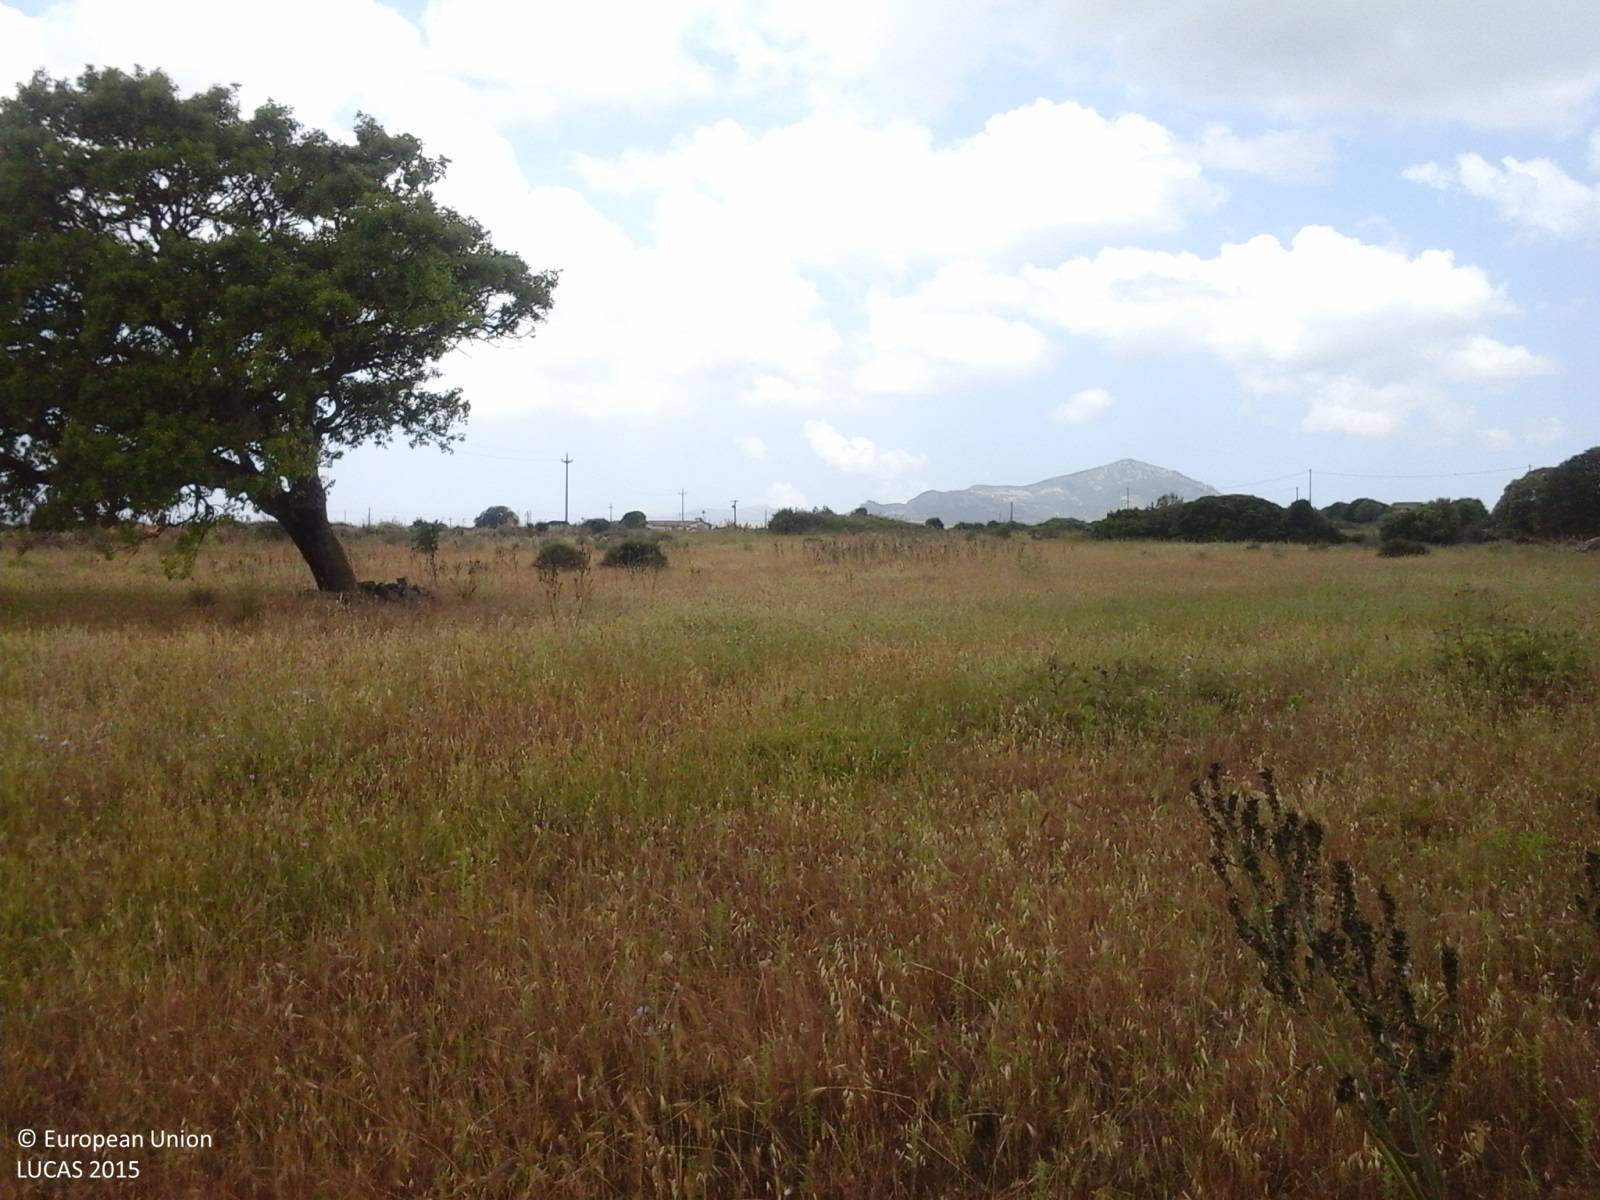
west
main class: Grassland
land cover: Grassland without tree/shrub cover
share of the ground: > 75 %
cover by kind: herbaceous plants 100 %
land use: Agriculture (excluding fallow land and kitchen gardens)
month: May
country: IT
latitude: 40.7058
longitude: 8.3391
